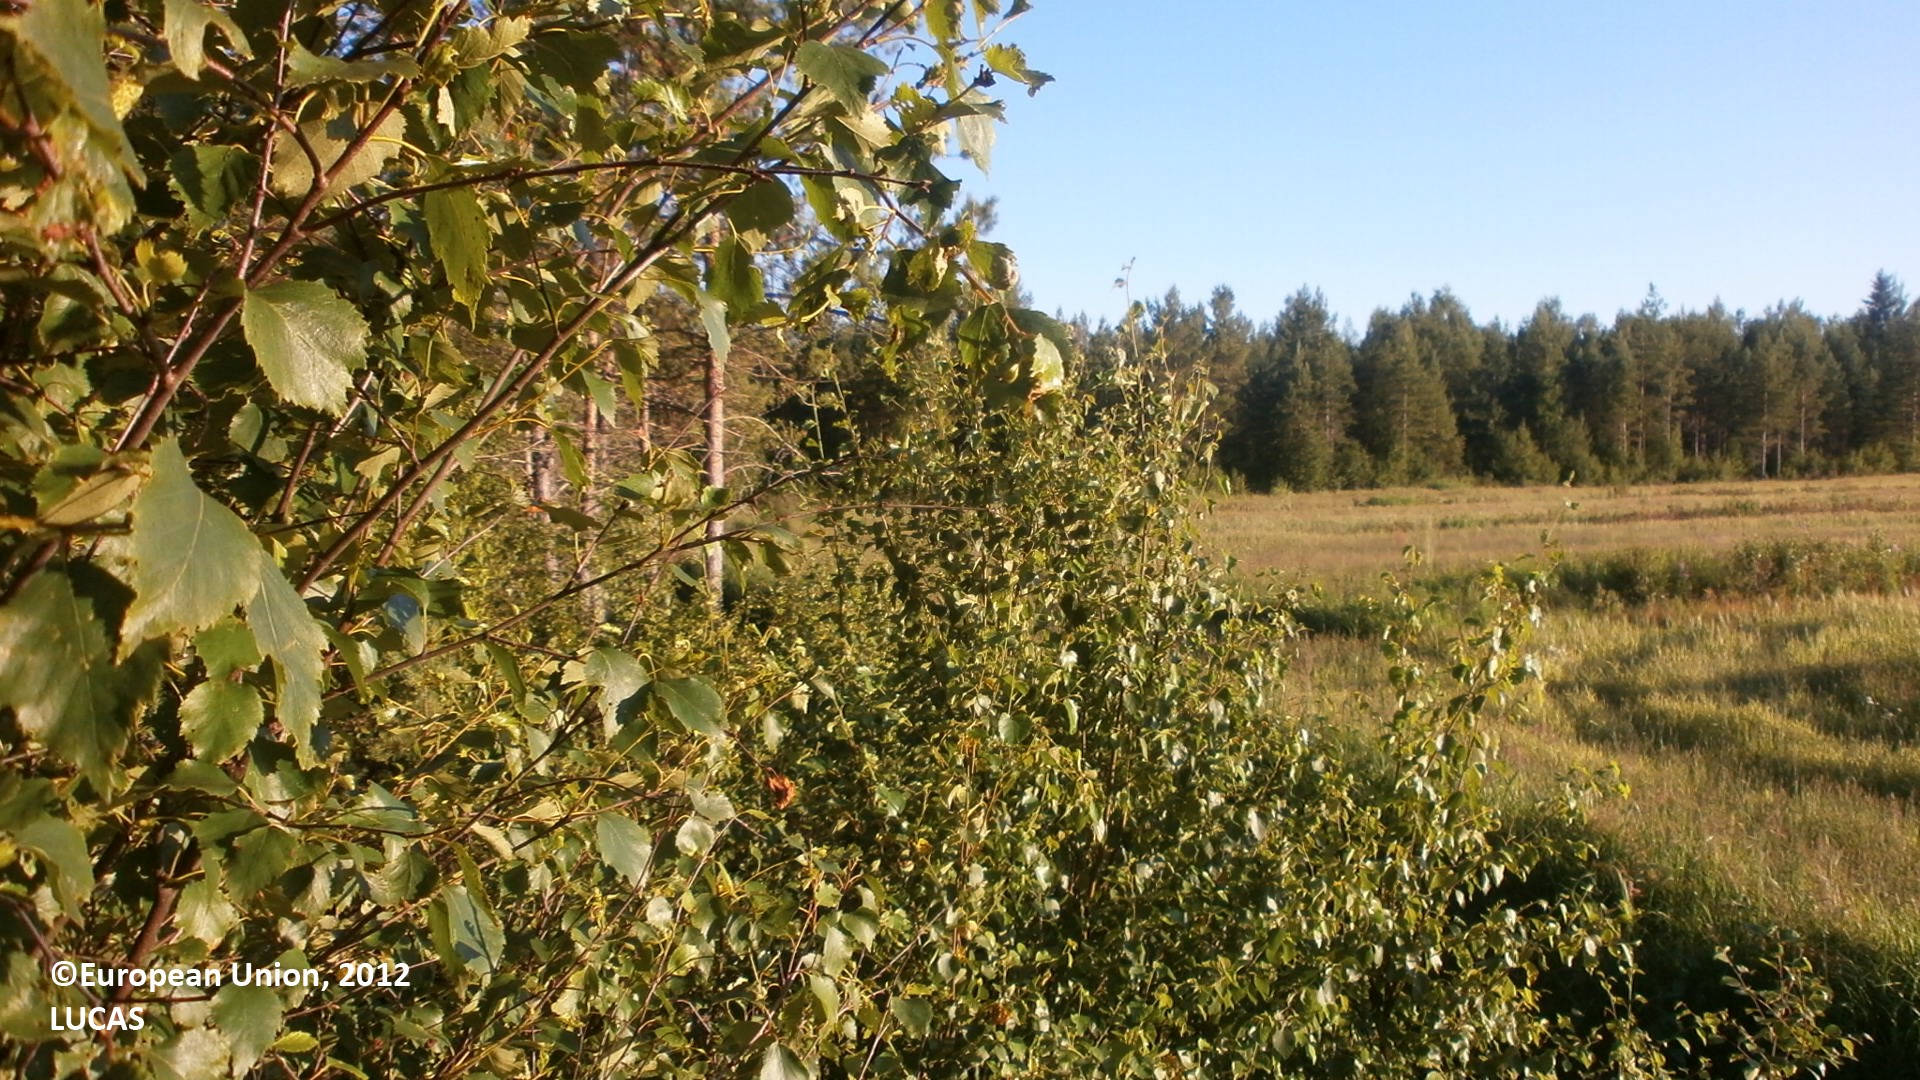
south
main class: Woodland
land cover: Pine dominated mixed woodland
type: boreal forest
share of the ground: 50 - 75 %
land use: Forestry
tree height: > 5 m
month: July
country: FI
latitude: 64.0412
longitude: 24.0927
